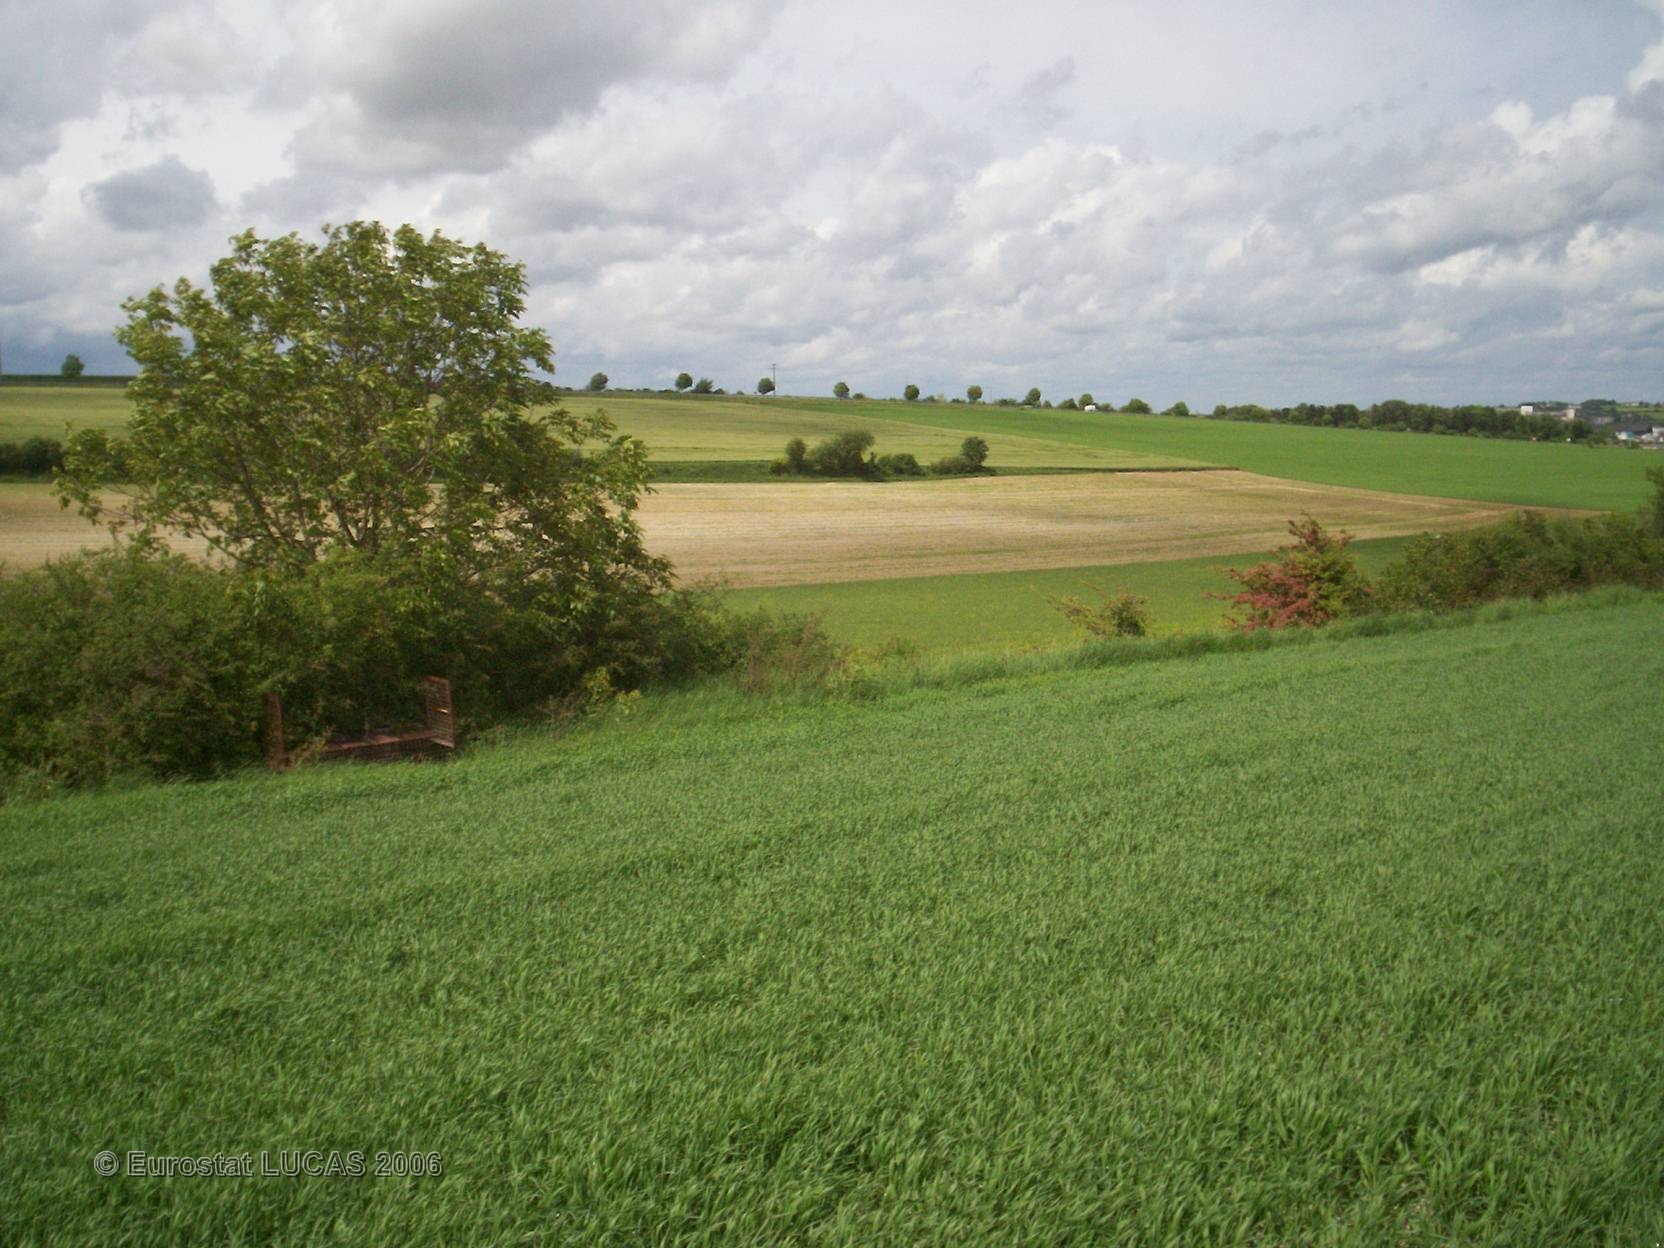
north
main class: Cropland
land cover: Barley
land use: Agriculture (excluding fallow land and kitchen gardens)
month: May
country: FR
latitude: 49.4853
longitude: 4.3501
